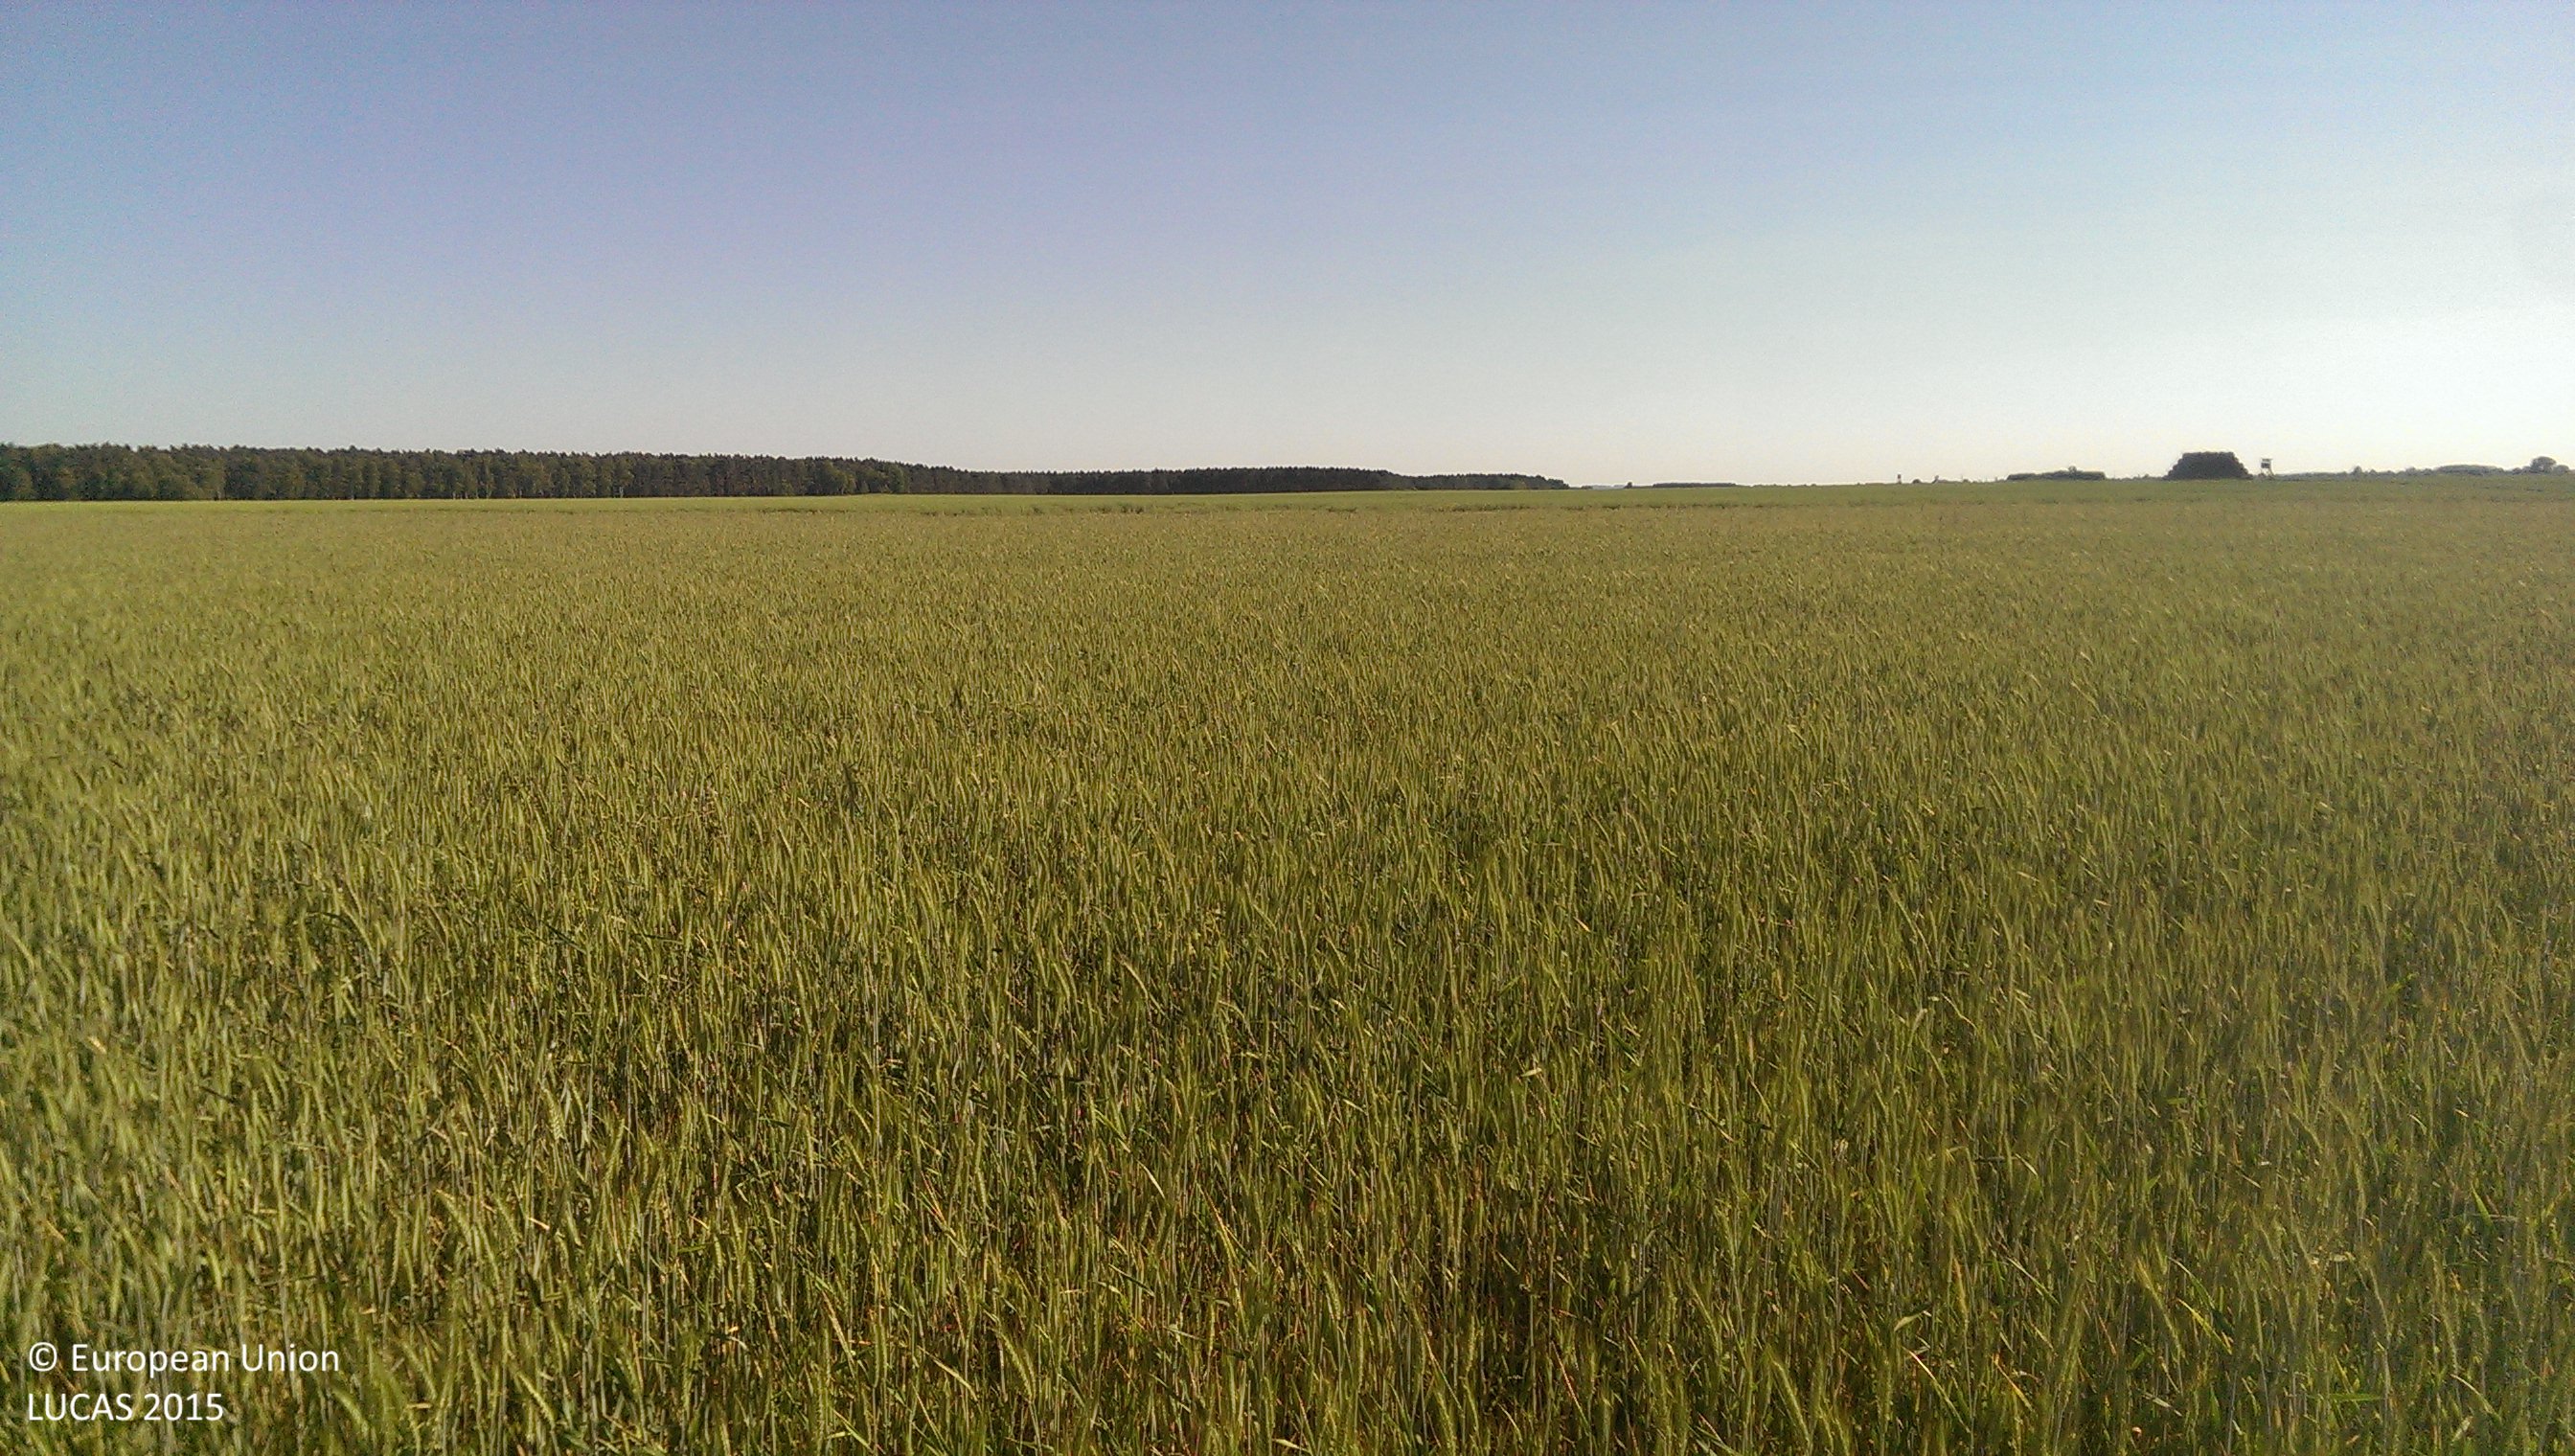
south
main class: Cropland
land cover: Triticale
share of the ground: > 75 %
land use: Agriculture (excluding fallow land and kitchen gardens)
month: June
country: PL
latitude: 51.8039
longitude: 16.1408
